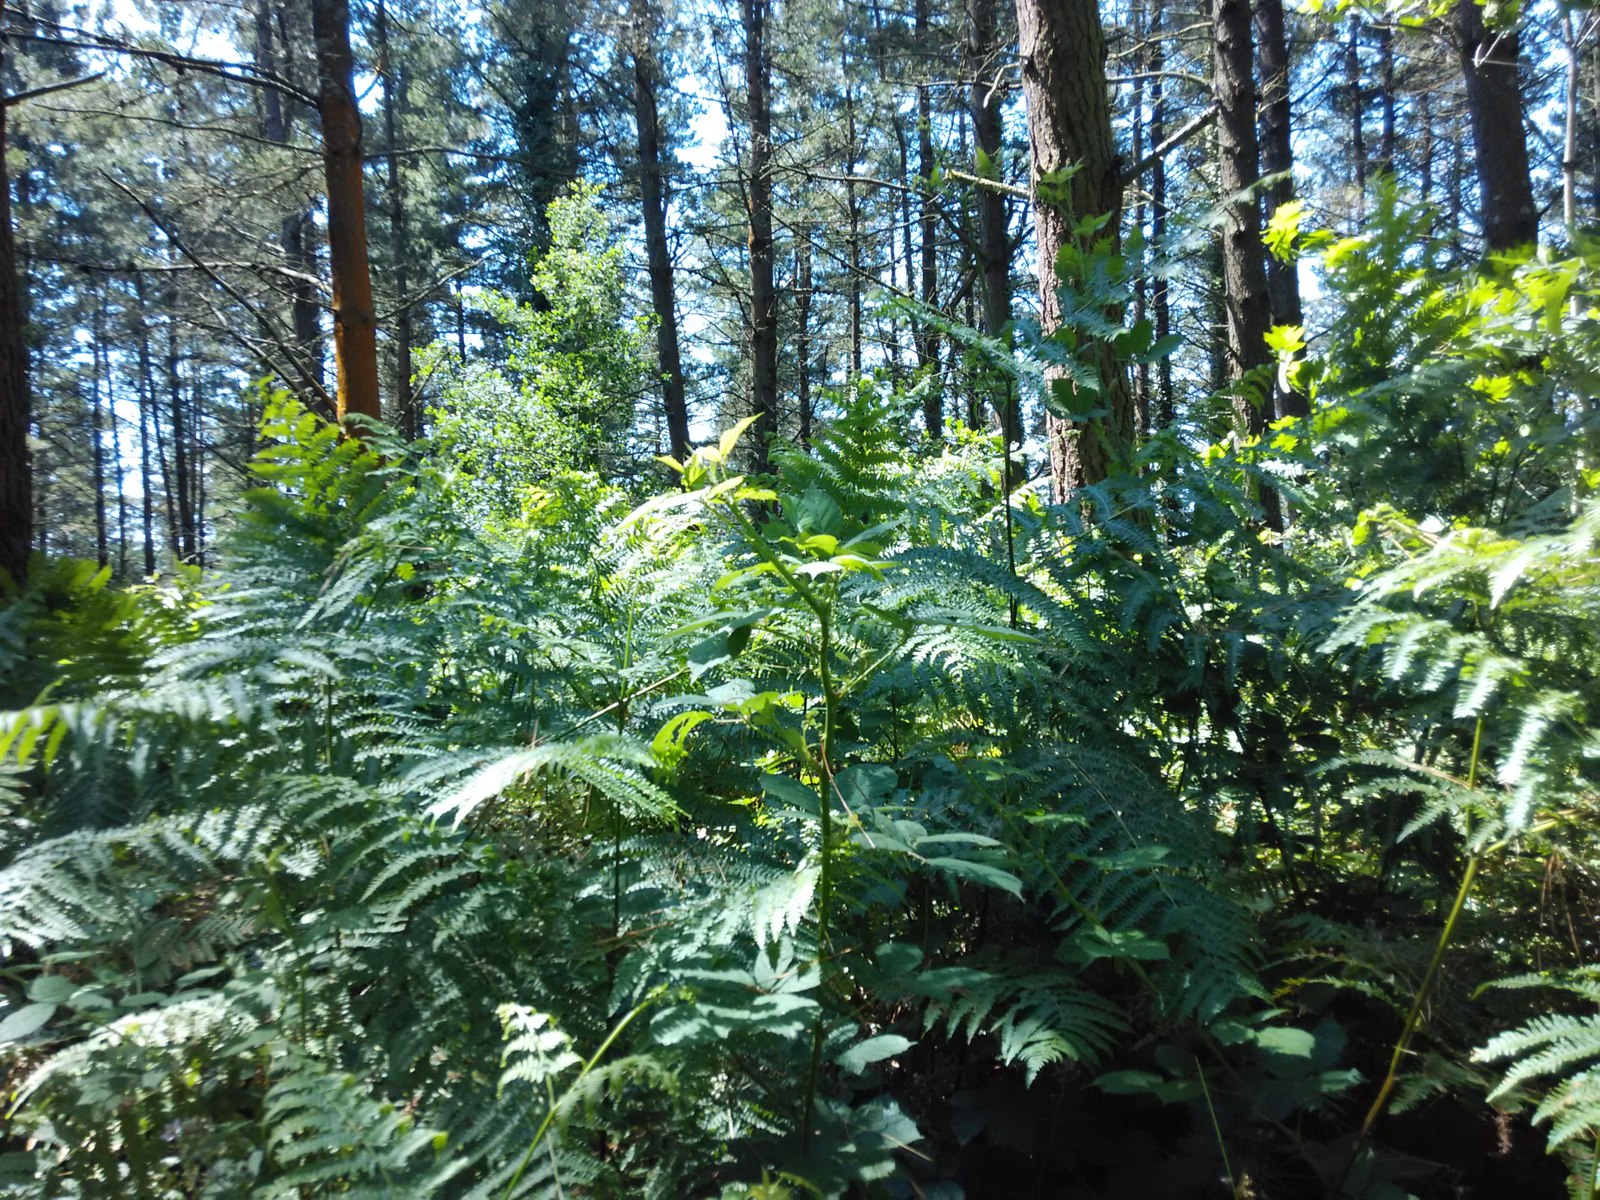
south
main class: Woodland
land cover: Pine dominated coniferous woodland
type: exotic forest
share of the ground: > 75 %
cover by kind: coniferous forest trees 100 %
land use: Forestry
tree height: > 5 m
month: July
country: ES
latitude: 43.1438
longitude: -2.2831
